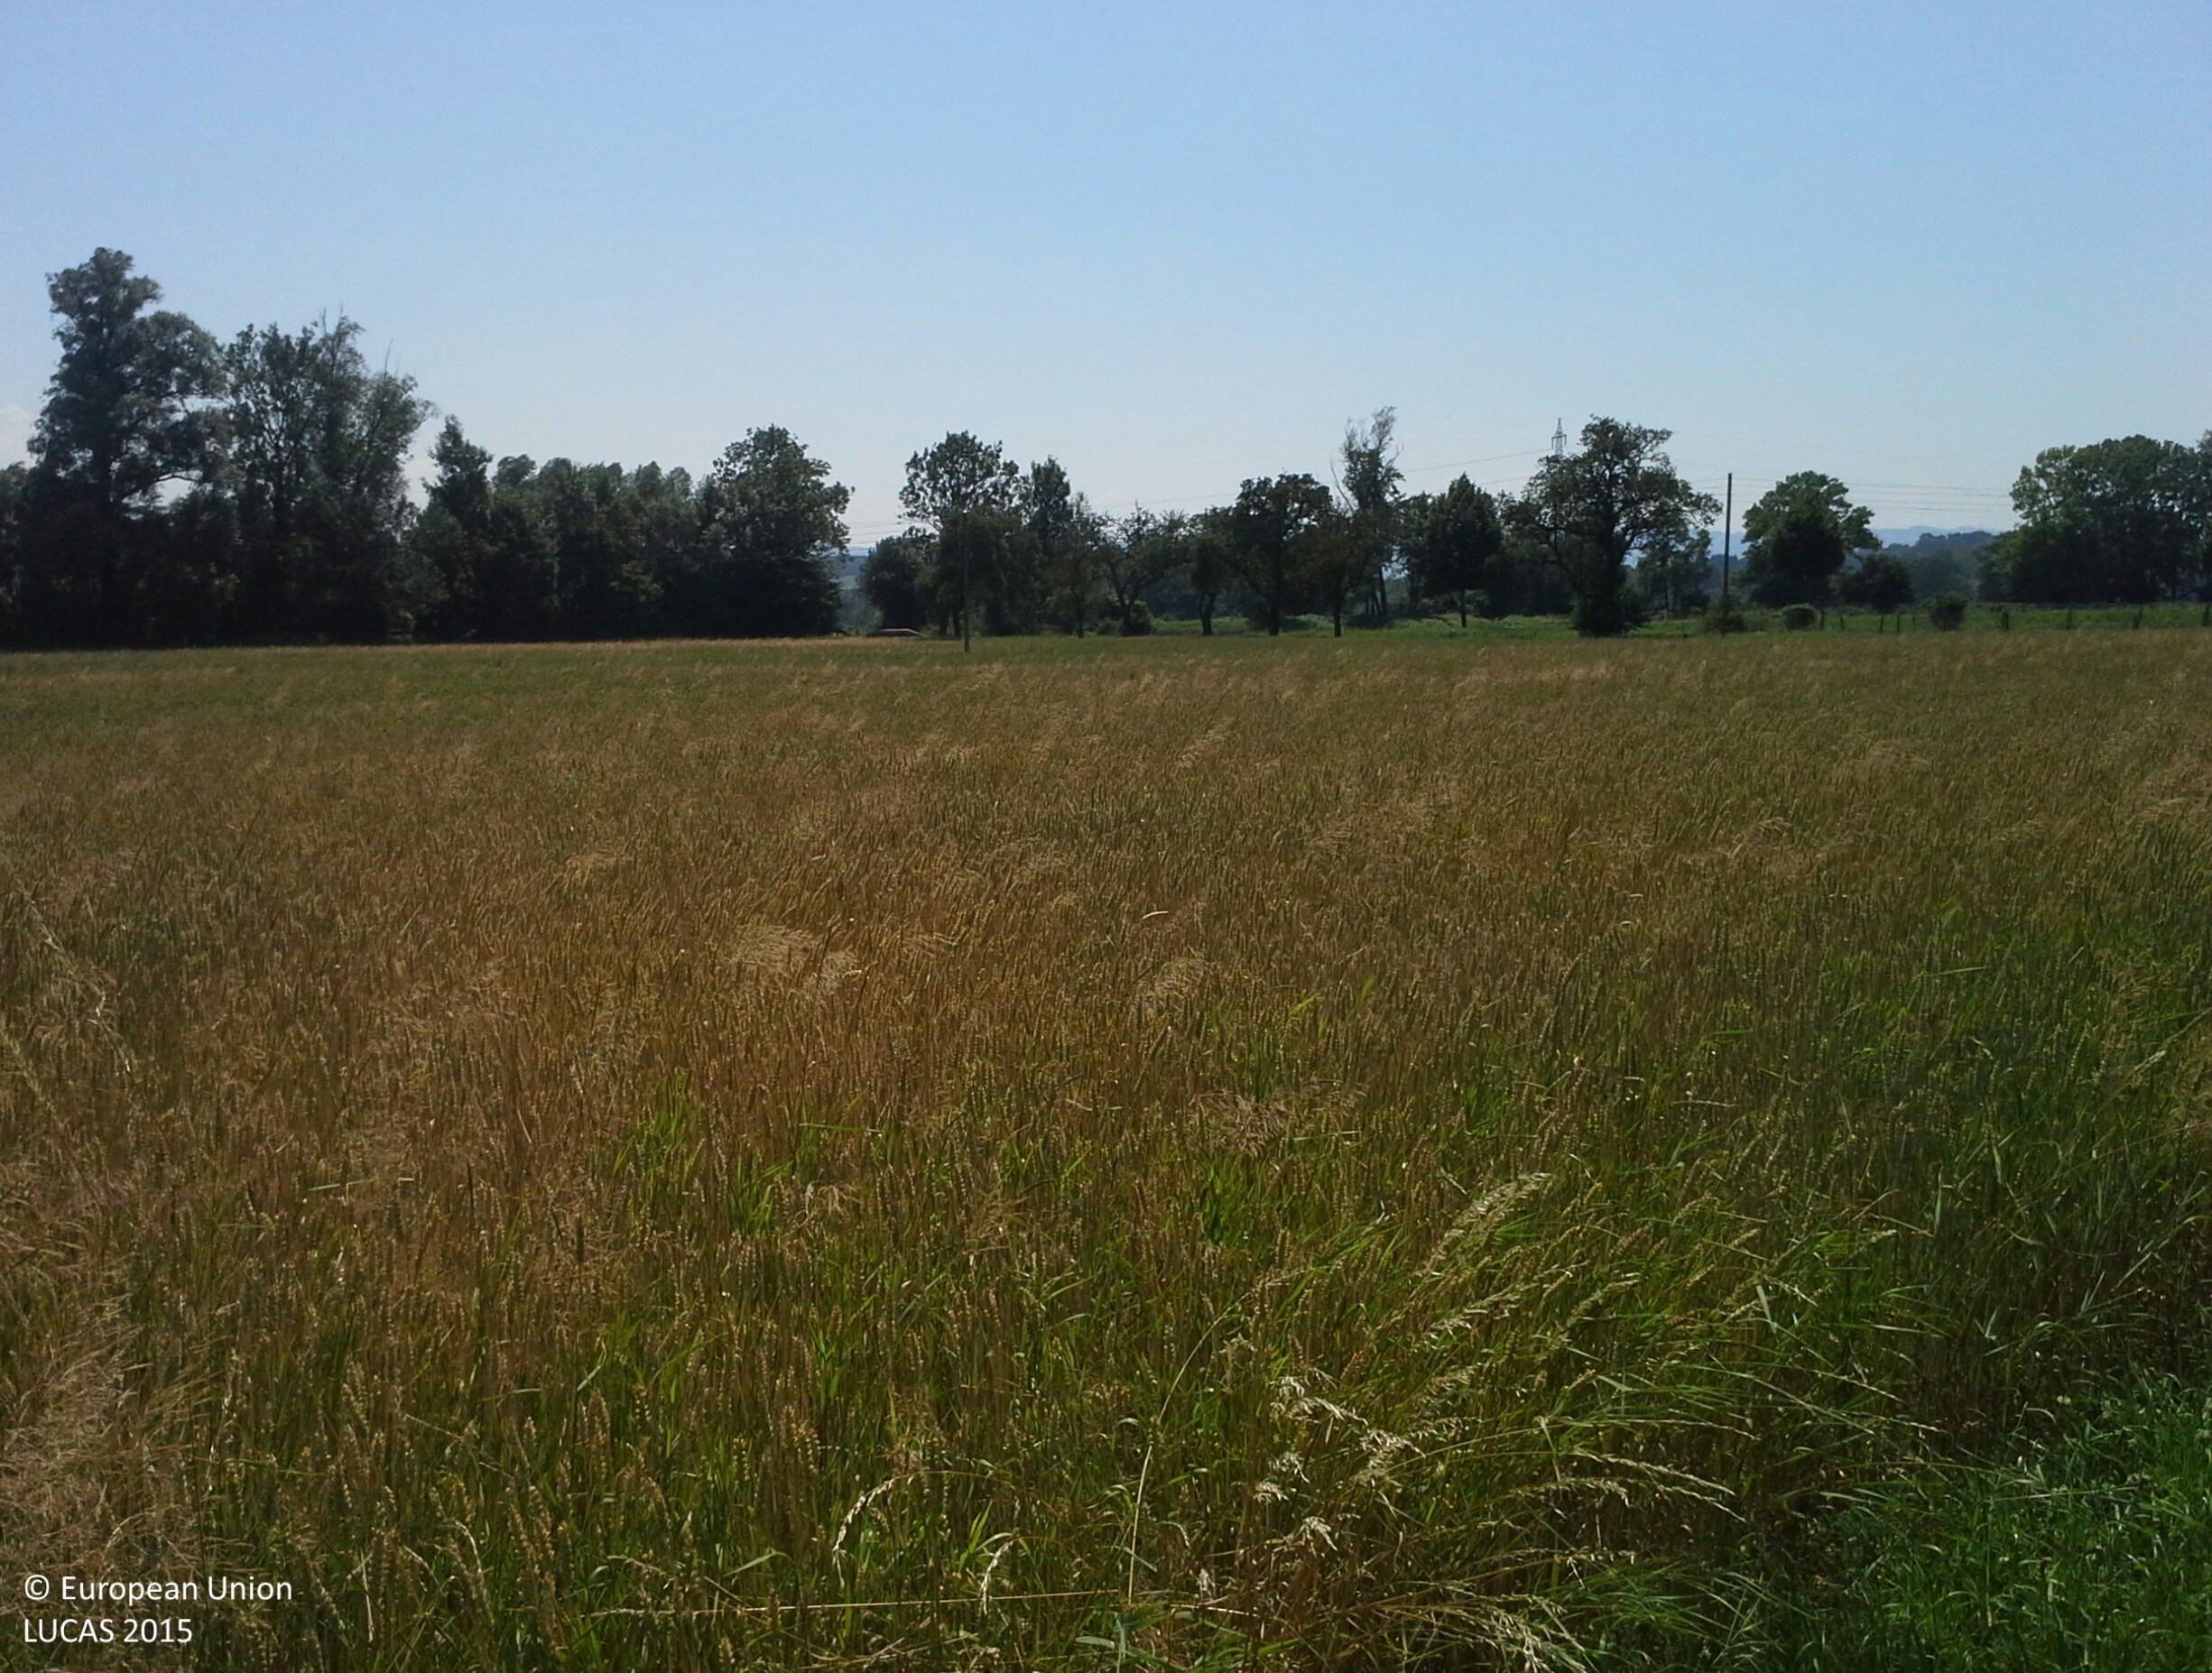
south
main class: Cropland
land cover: Pear fruit
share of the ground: 10 - 25 %
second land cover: Grassland without tree/shrub cover
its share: > 75 %
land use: Agriculture (excluding fallow land and kitchen gardens)
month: July
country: AT
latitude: 48.1276
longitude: 15.0126
